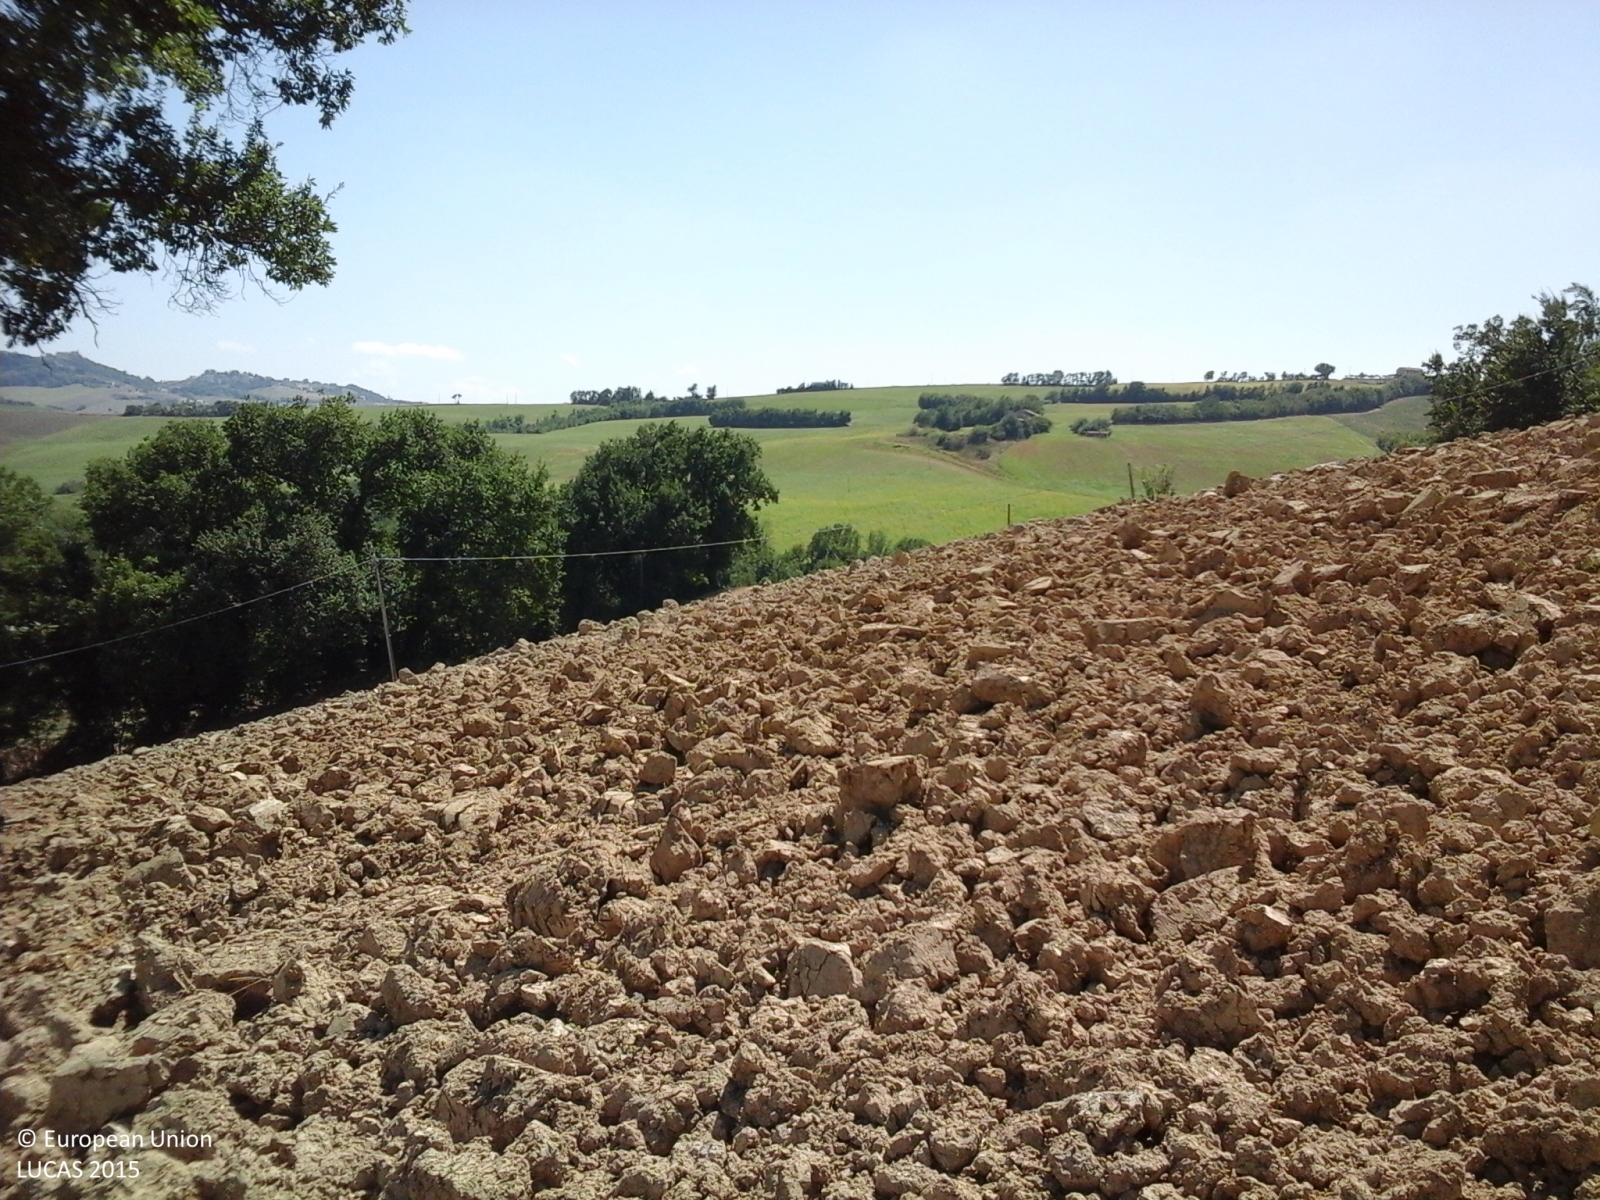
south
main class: Cropland
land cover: Durum wheat
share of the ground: > 75 %
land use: Agriculture (excluding fallow land and kitchen gardens)
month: August
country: IT
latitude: 43.1736
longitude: 13.4476
